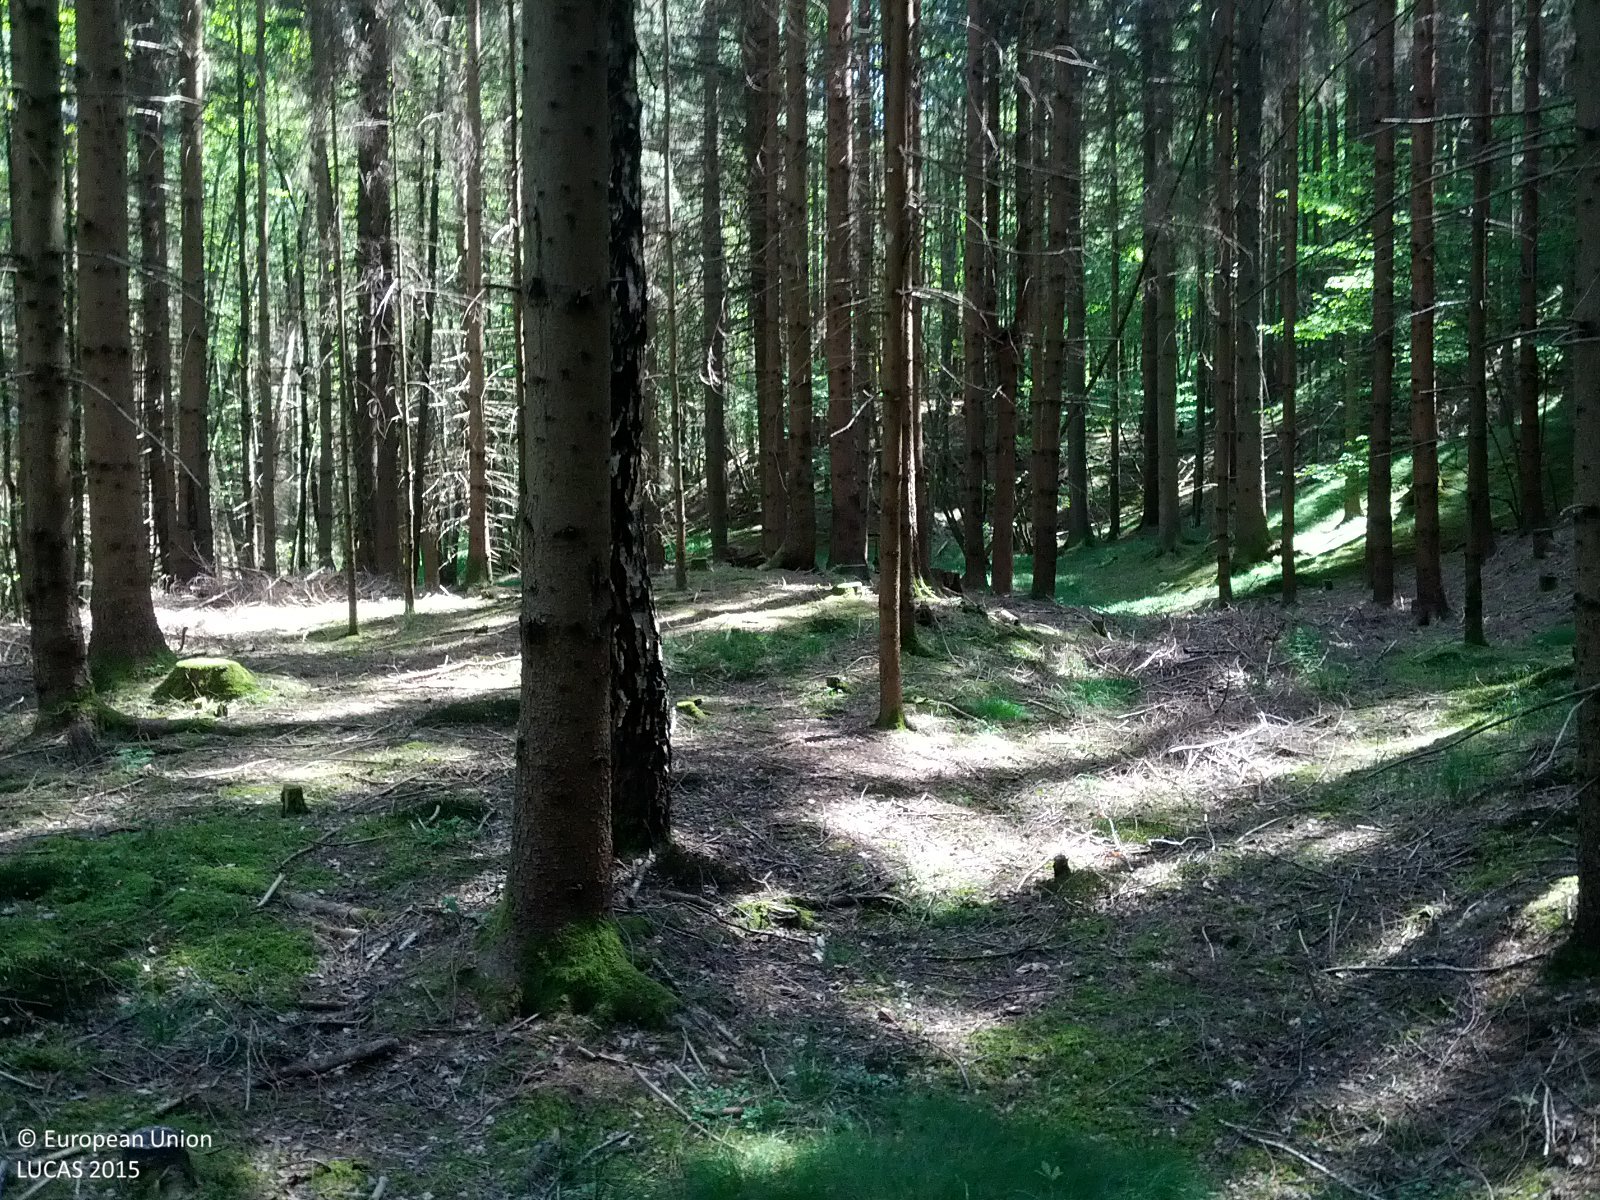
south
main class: Woodland
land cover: Spruce dominated coniferous woodland
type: boreal forest
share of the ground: > 75 %
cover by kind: coniferous forest trees 80 %, lichens and mosses 10 %, broadleaved forest trees 5 %, herbaceous plants 5 %
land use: Forestry
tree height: > 5 m
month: May
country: AT
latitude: 47.4057
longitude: 16.0847
